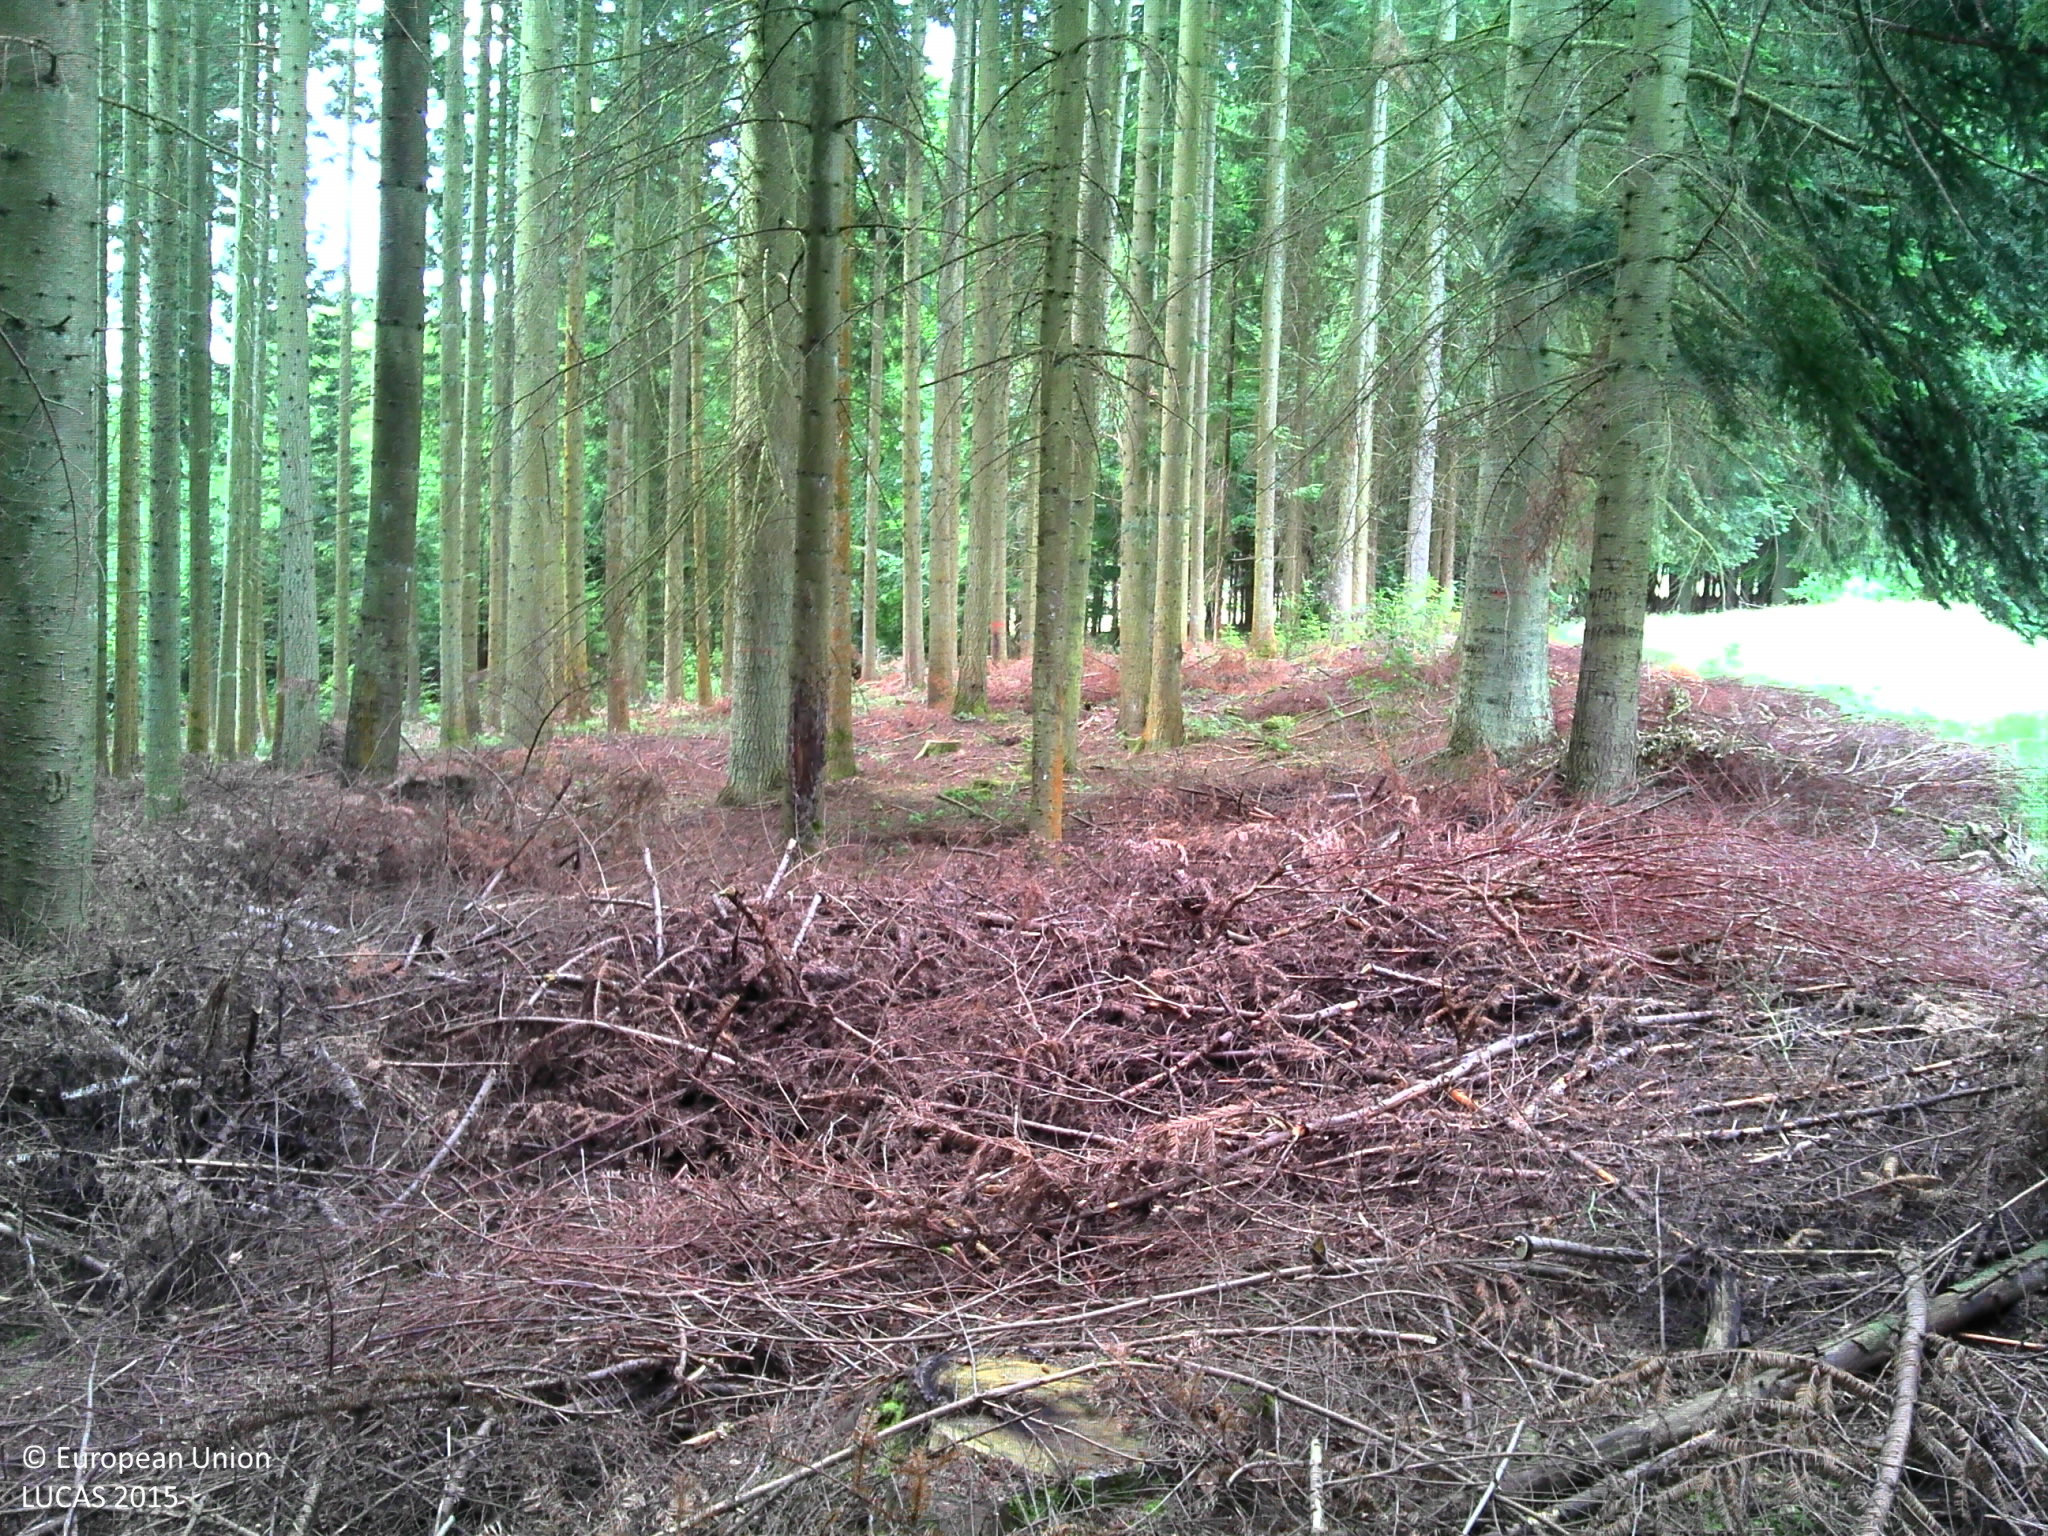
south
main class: Woodland
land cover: Other coniferous woodland
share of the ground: > 75 %
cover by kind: coniferous forest trees 80 %, unconsolidated bare surface 20 %
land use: Forestry
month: July
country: BE
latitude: 50.3081
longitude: 5.8848
